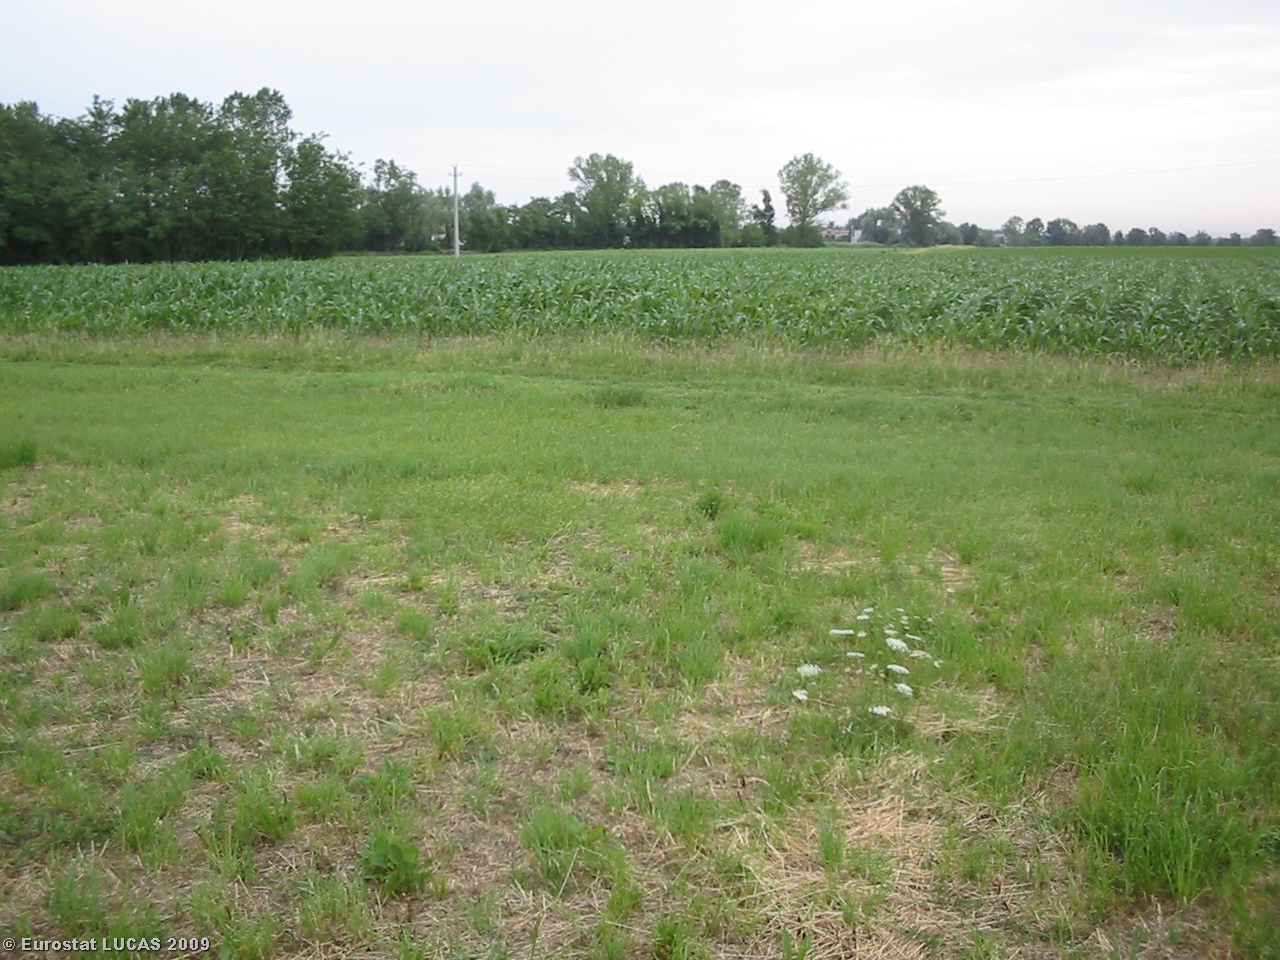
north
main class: Grassland
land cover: Grassland without tree/shrub cover
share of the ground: > 75 %
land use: Agriculture (excluding fallow land and kitchen gardens)
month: June
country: IT
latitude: 44.6929
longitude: 10.2644
